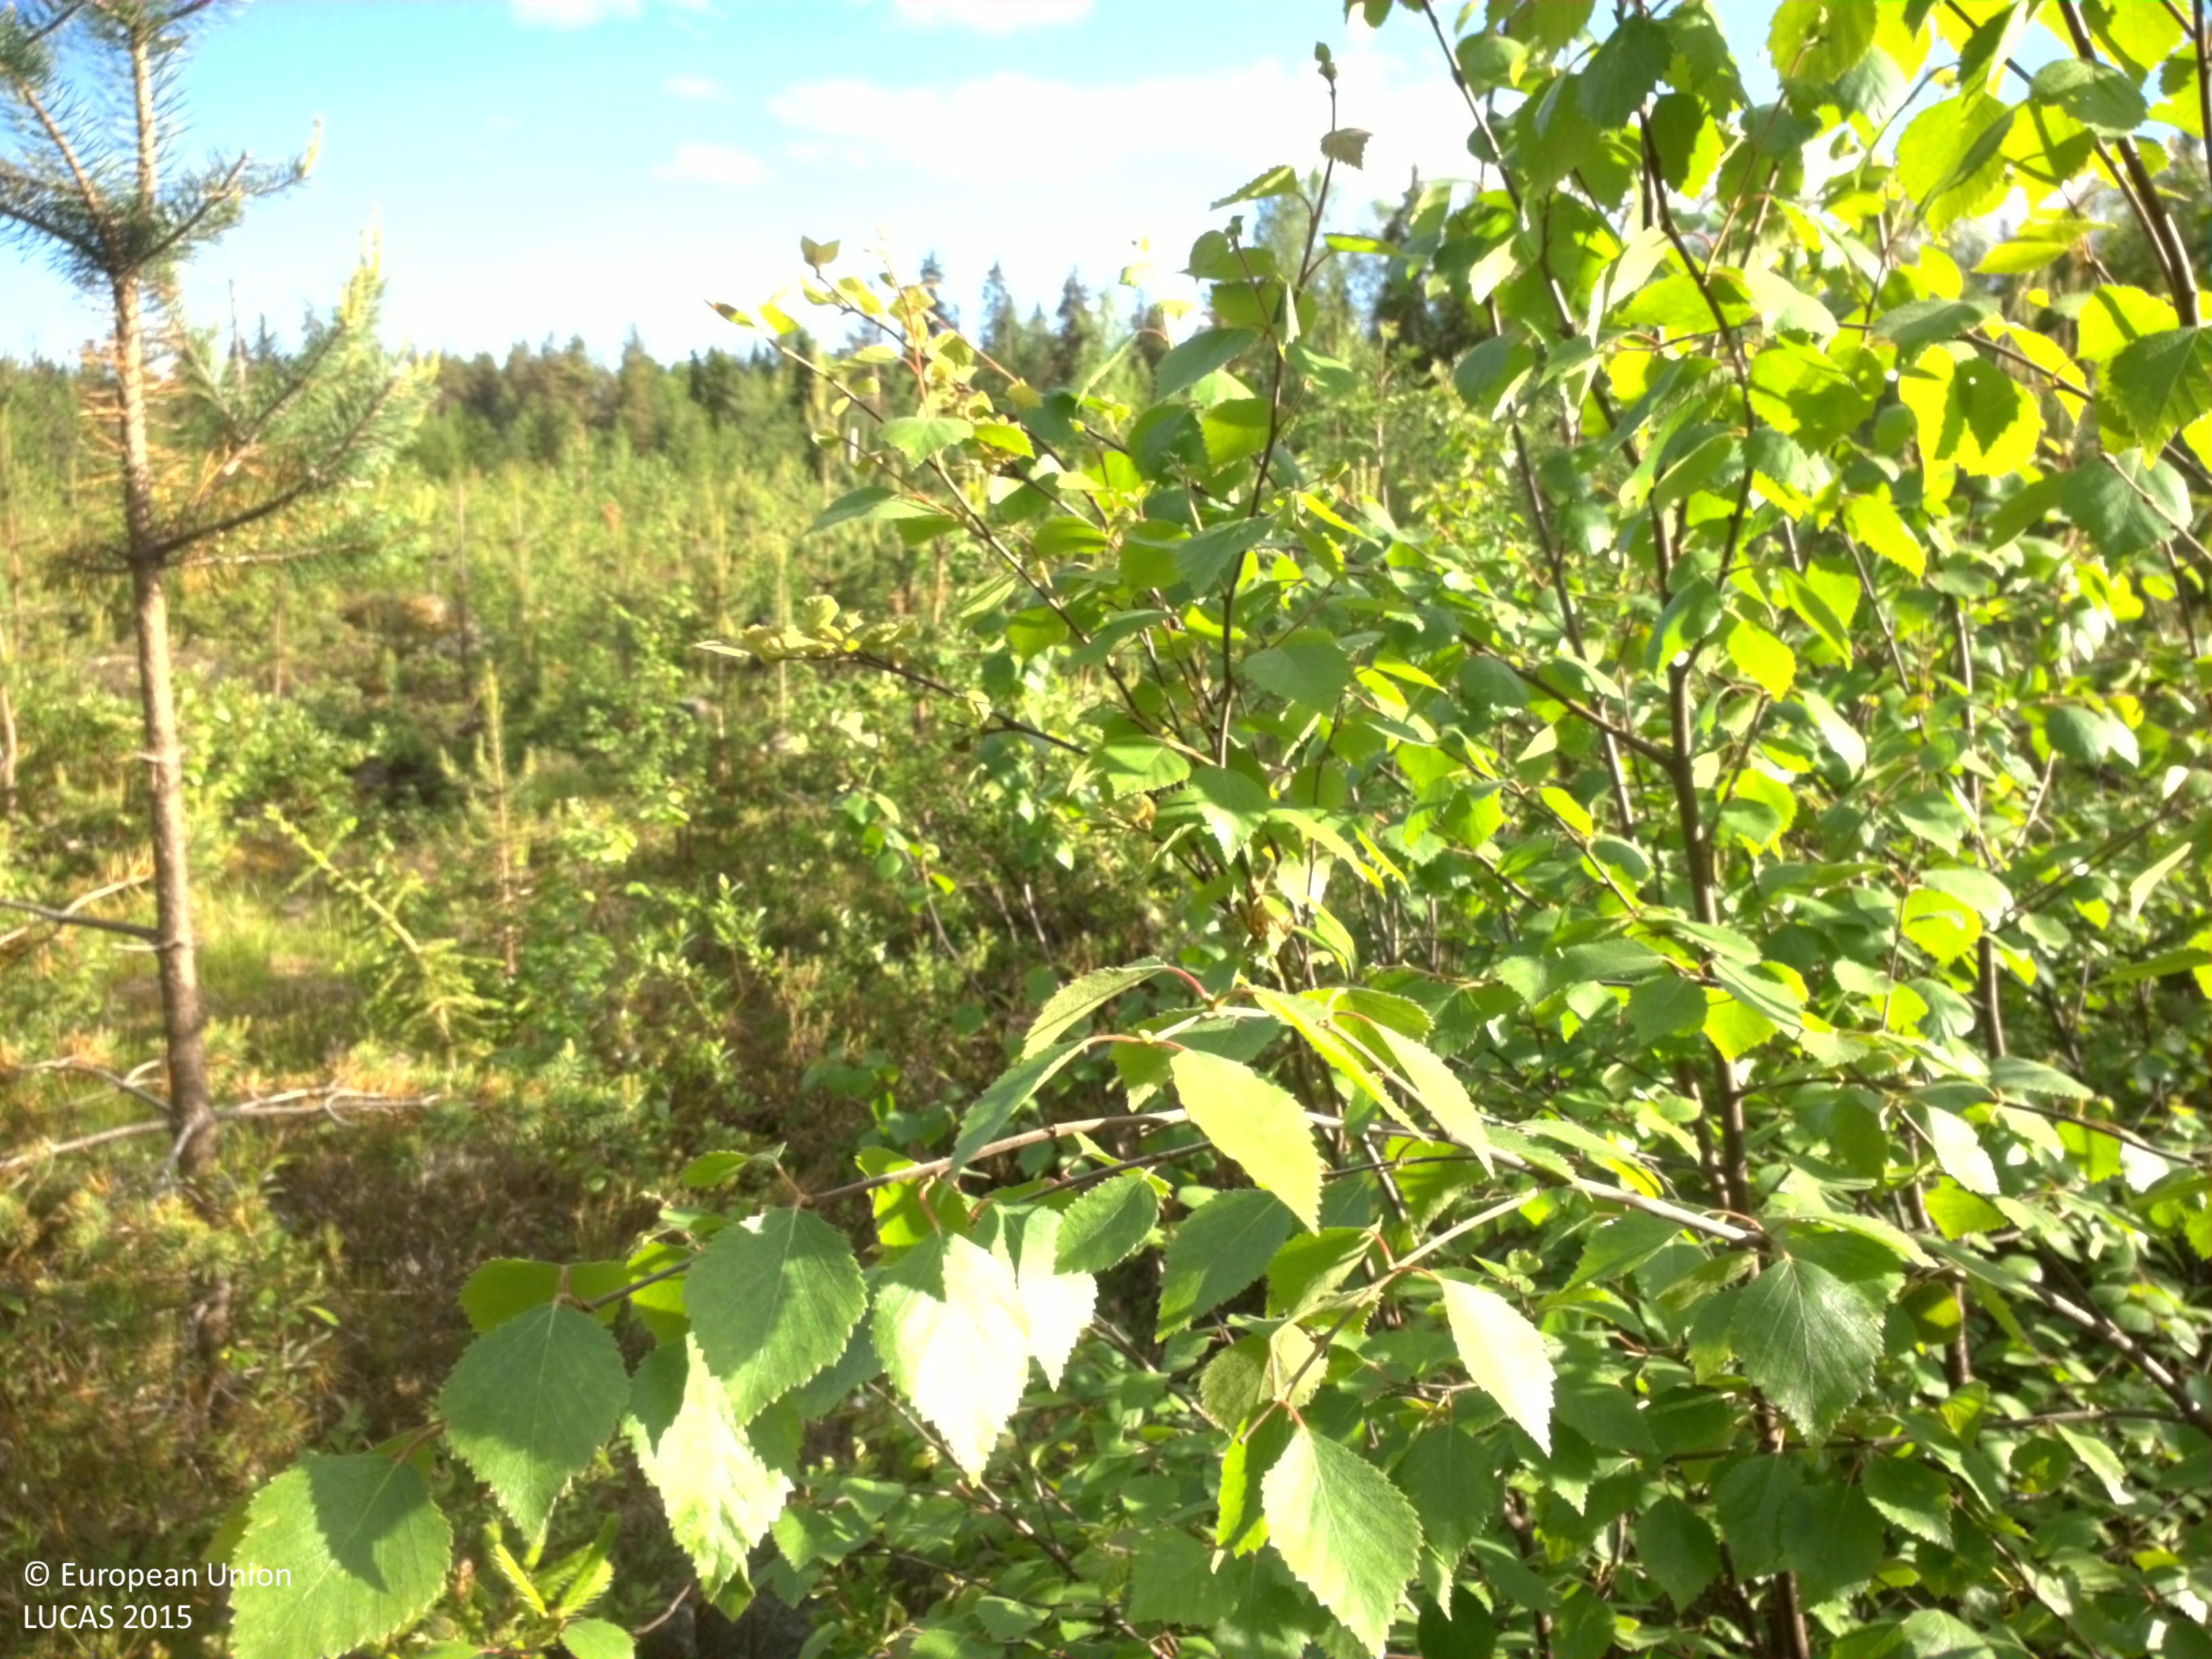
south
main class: Woodland
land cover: Pine dominated mixed woodland
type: boreal forest
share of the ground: 50 - 75 %
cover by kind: broadleaved forest trees 45 %, shrubs 30 %, coniferous forest trees 20 %, lichens and mosses 5 %
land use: Forestry
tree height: < 5 m
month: June
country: SE
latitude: 66.3827
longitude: 22.7034
